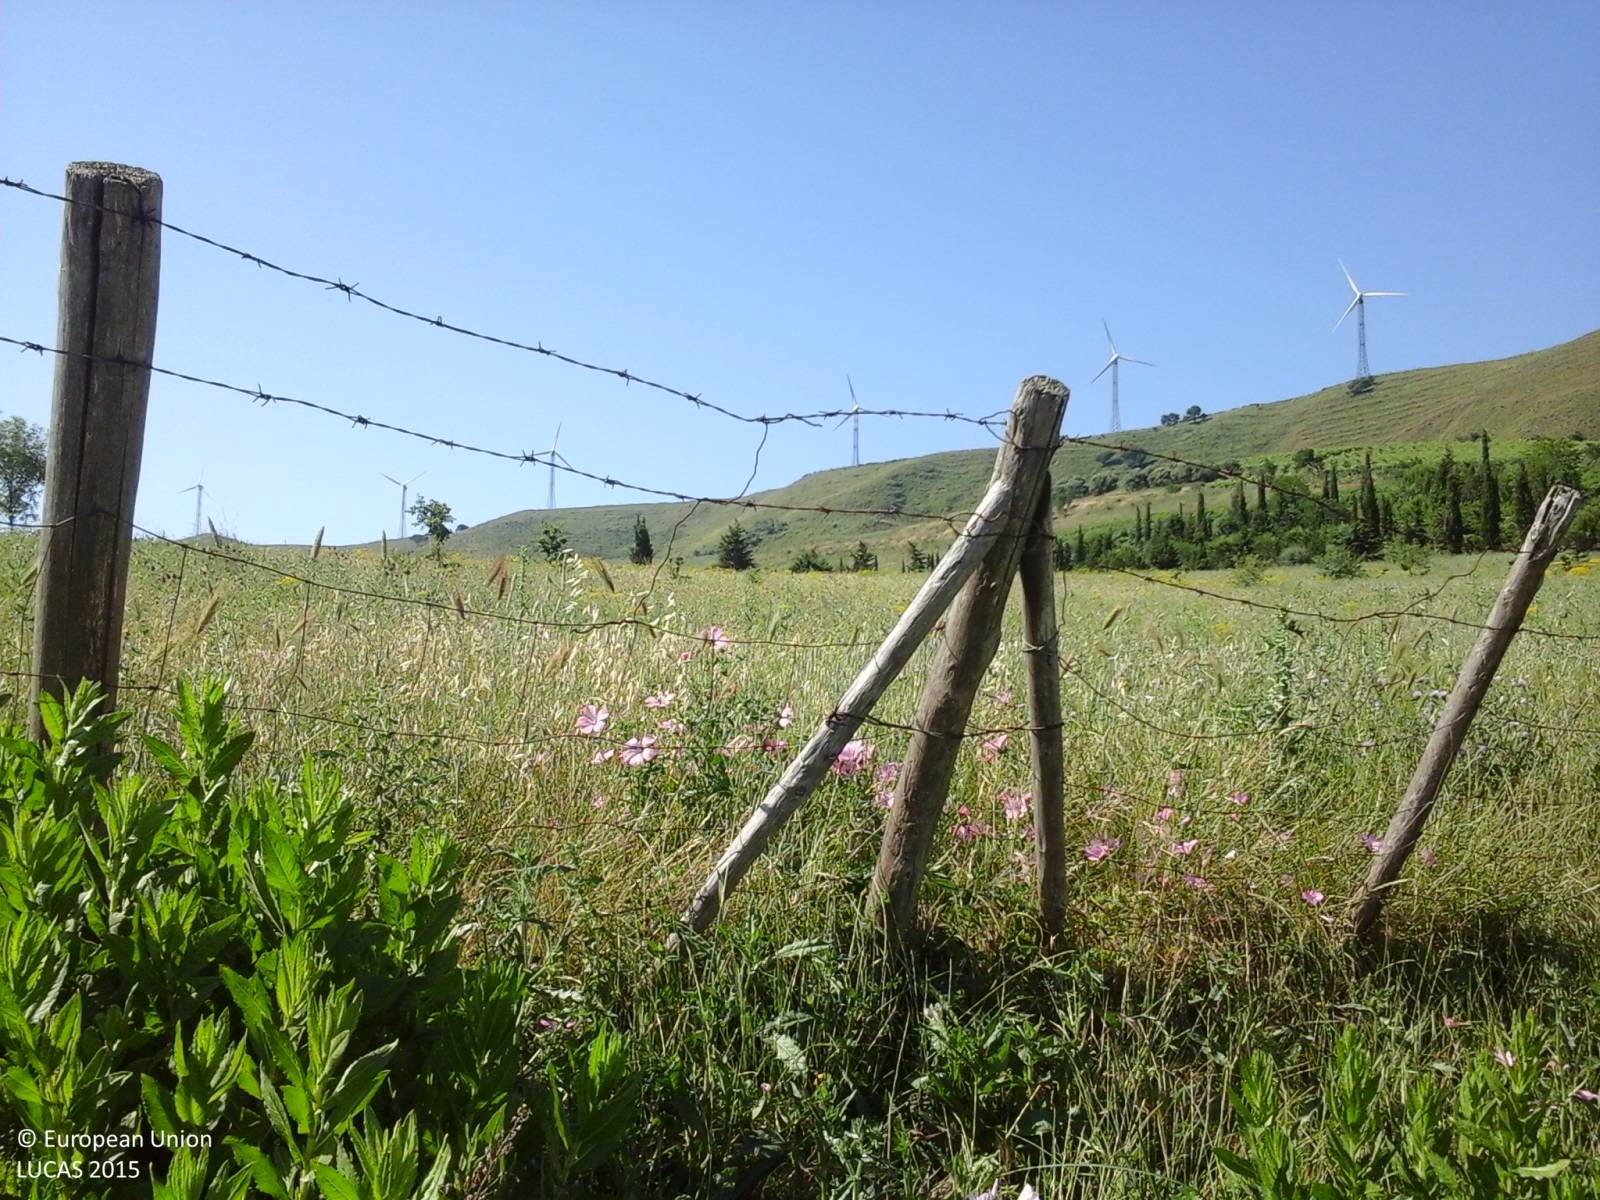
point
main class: Grassland
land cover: Grassland without tree/shrub cover
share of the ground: > 75 %
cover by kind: herbaceous plants 100 %
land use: Semi-natural and natural areas not in use
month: June
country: IT
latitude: 37.9699
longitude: 13.0854
